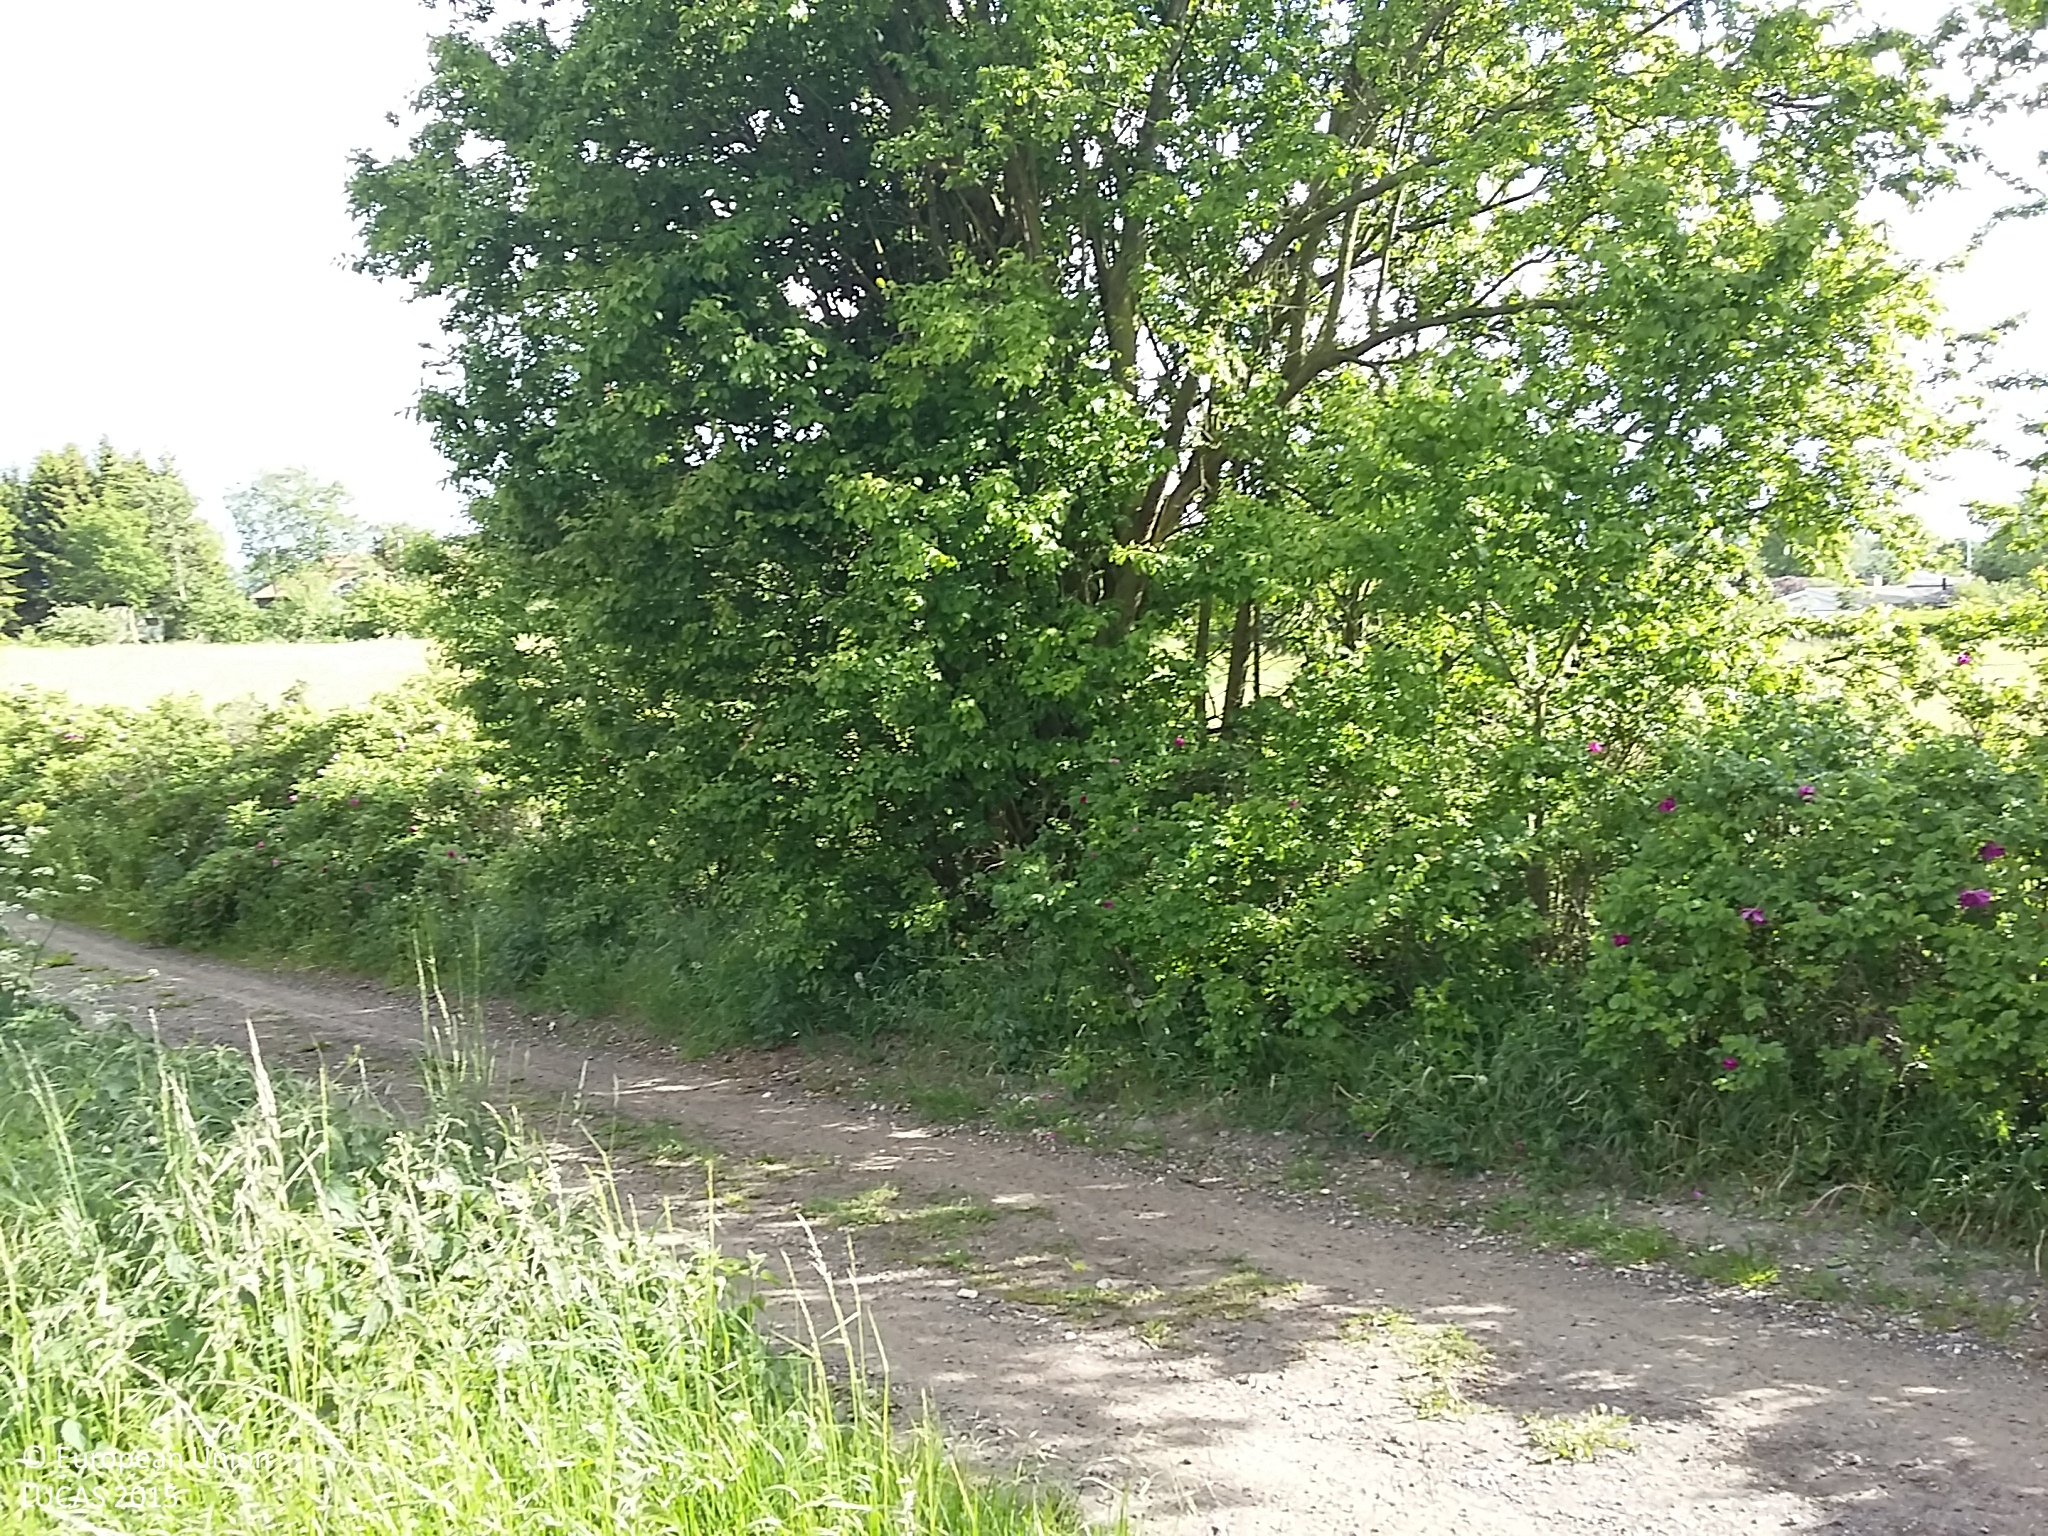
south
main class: Woodland
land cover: Broadleaved woodland
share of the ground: > 75 %
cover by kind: herbaceous plants 60 %, broadleaved forest trees 40 %
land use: Agriculture (excluding fallow land and kitchen gardens)
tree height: > 5 m
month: June
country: DK
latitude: 55.3408
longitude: 10.7404
